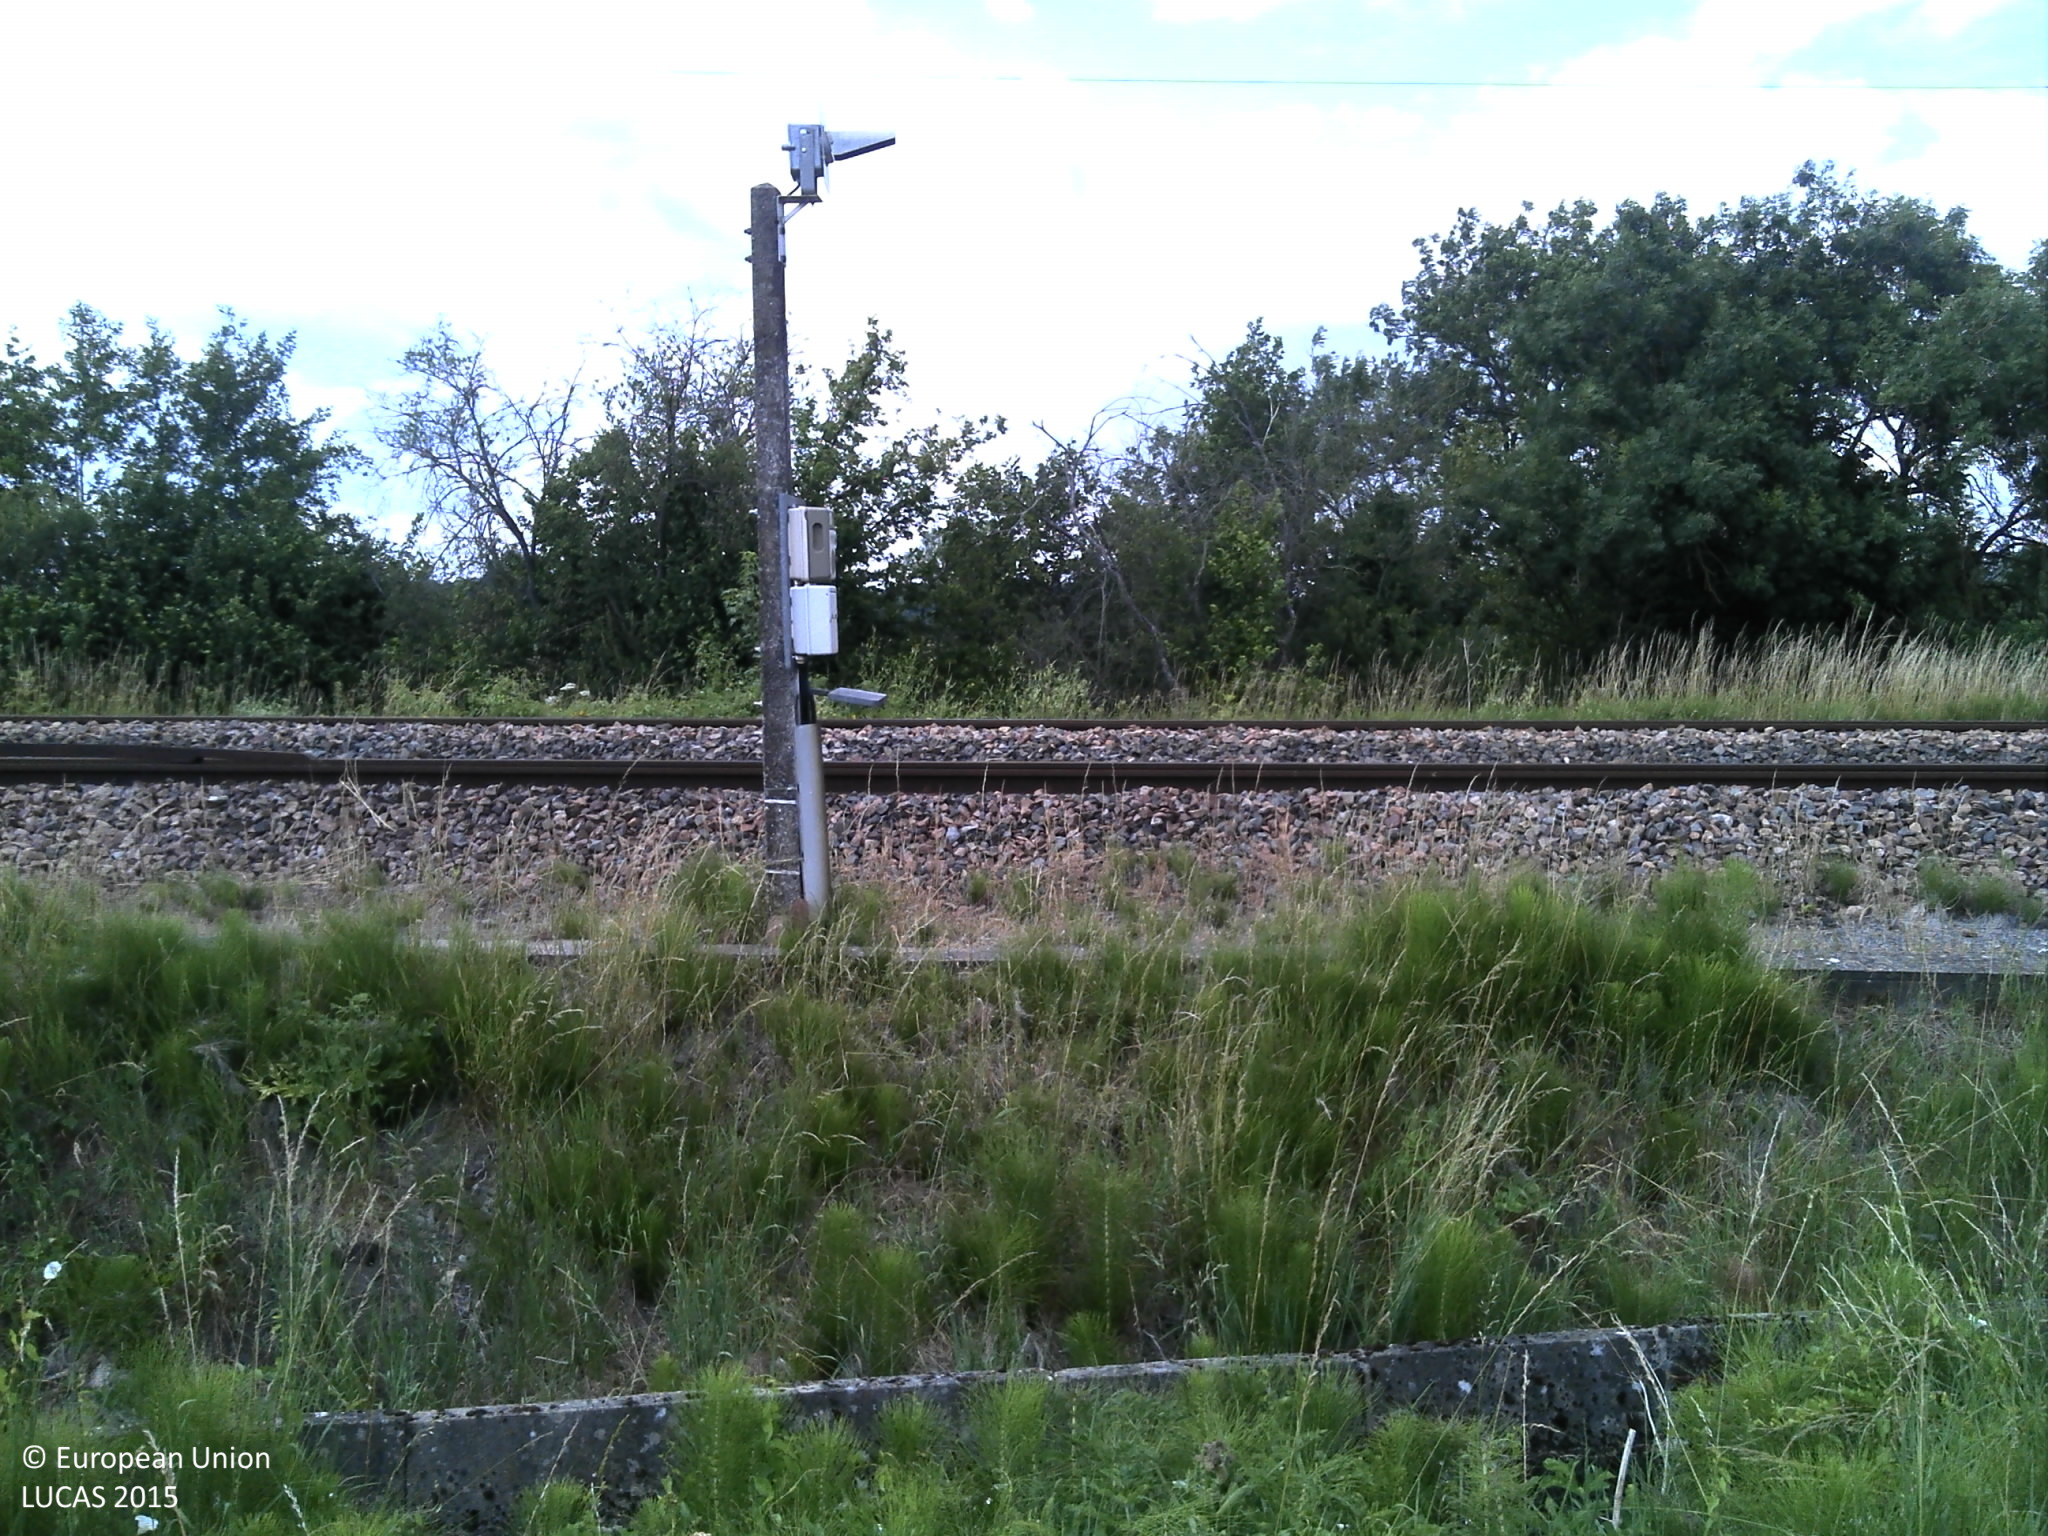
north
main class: Artificial land
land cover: Non built-up linear features
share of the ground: > 75 %
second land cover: Spontaneously vegetated surfaces
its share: 25 - 50 %
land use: Road transport
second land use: Agriculture (excluding fallow land and kitchen gardens)
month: July
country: FR
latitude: 49.6422
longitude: 4.6095
